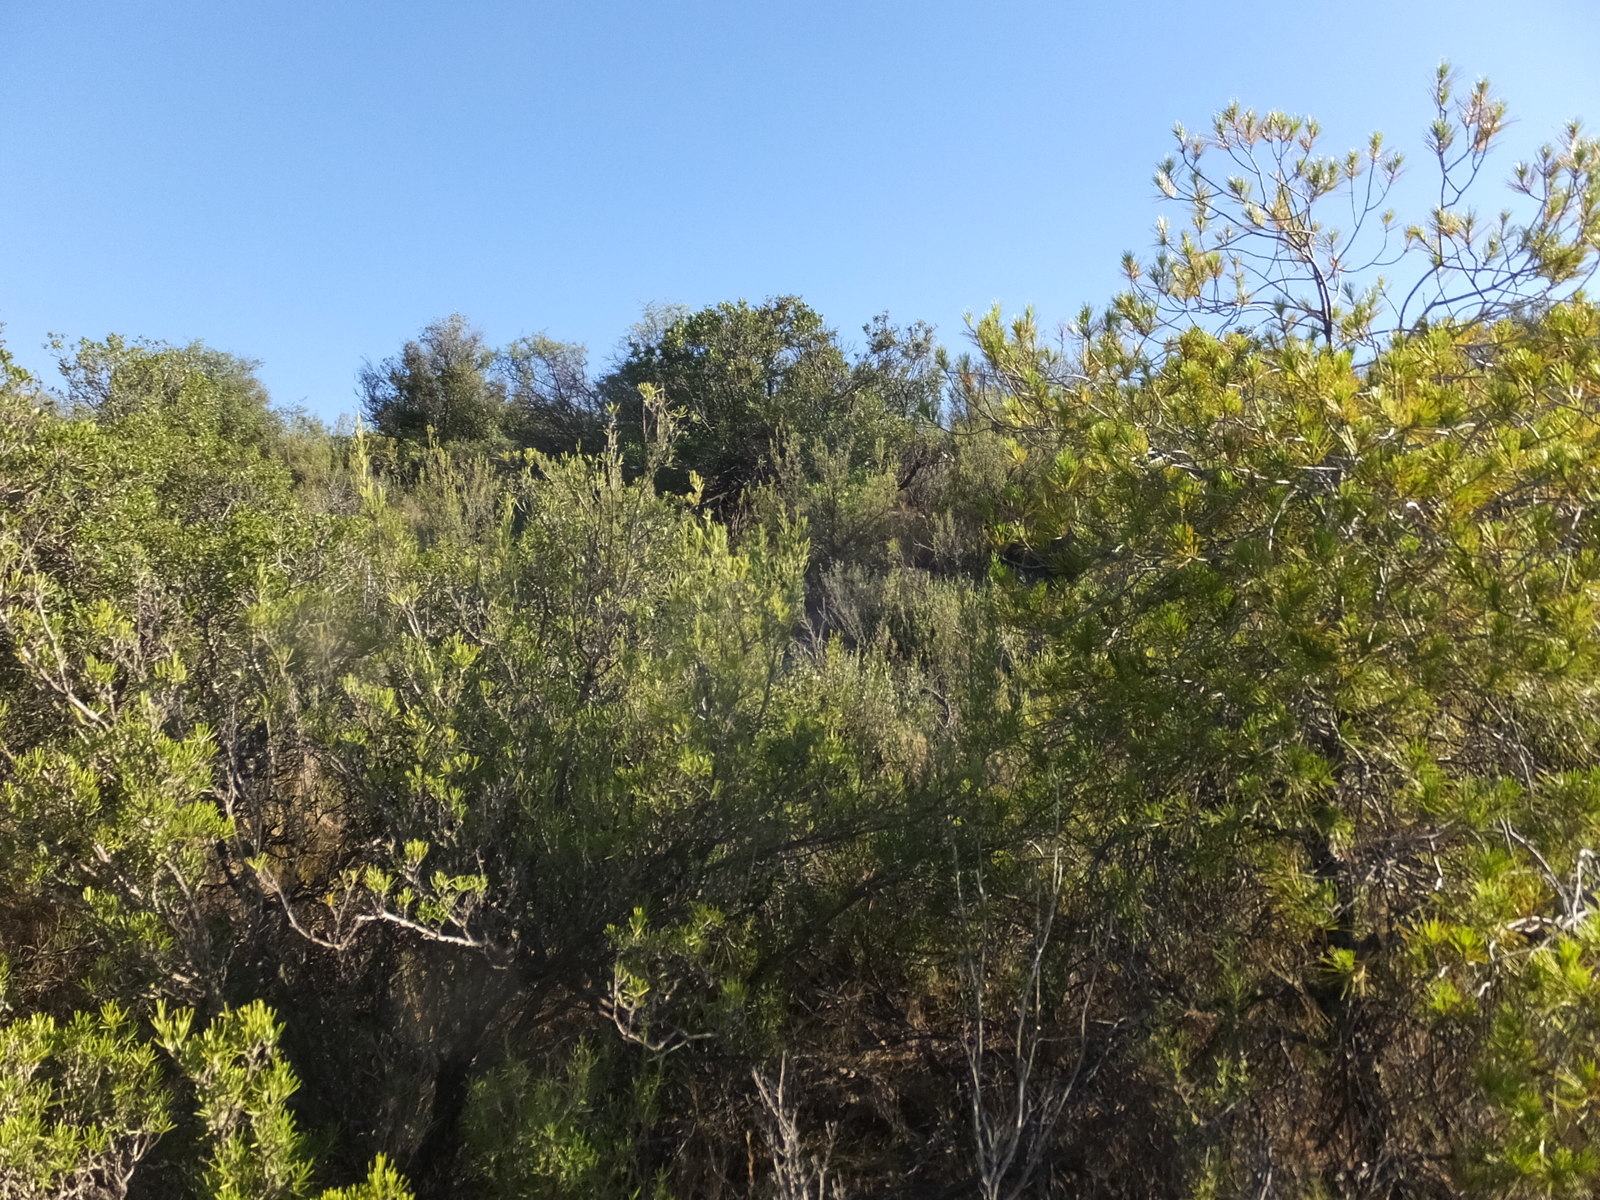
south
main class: Shrubland
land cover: Shrubland with sparse tree cover
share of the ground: > 75 %
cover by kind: shrubs 75 %, herbaceous plants 20 %, coniferous forest trees 5 %
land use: Semi-natural and natural areas not in use
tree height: < 5 m
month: July
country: ES
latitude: 41.4128
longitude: 0.1891
